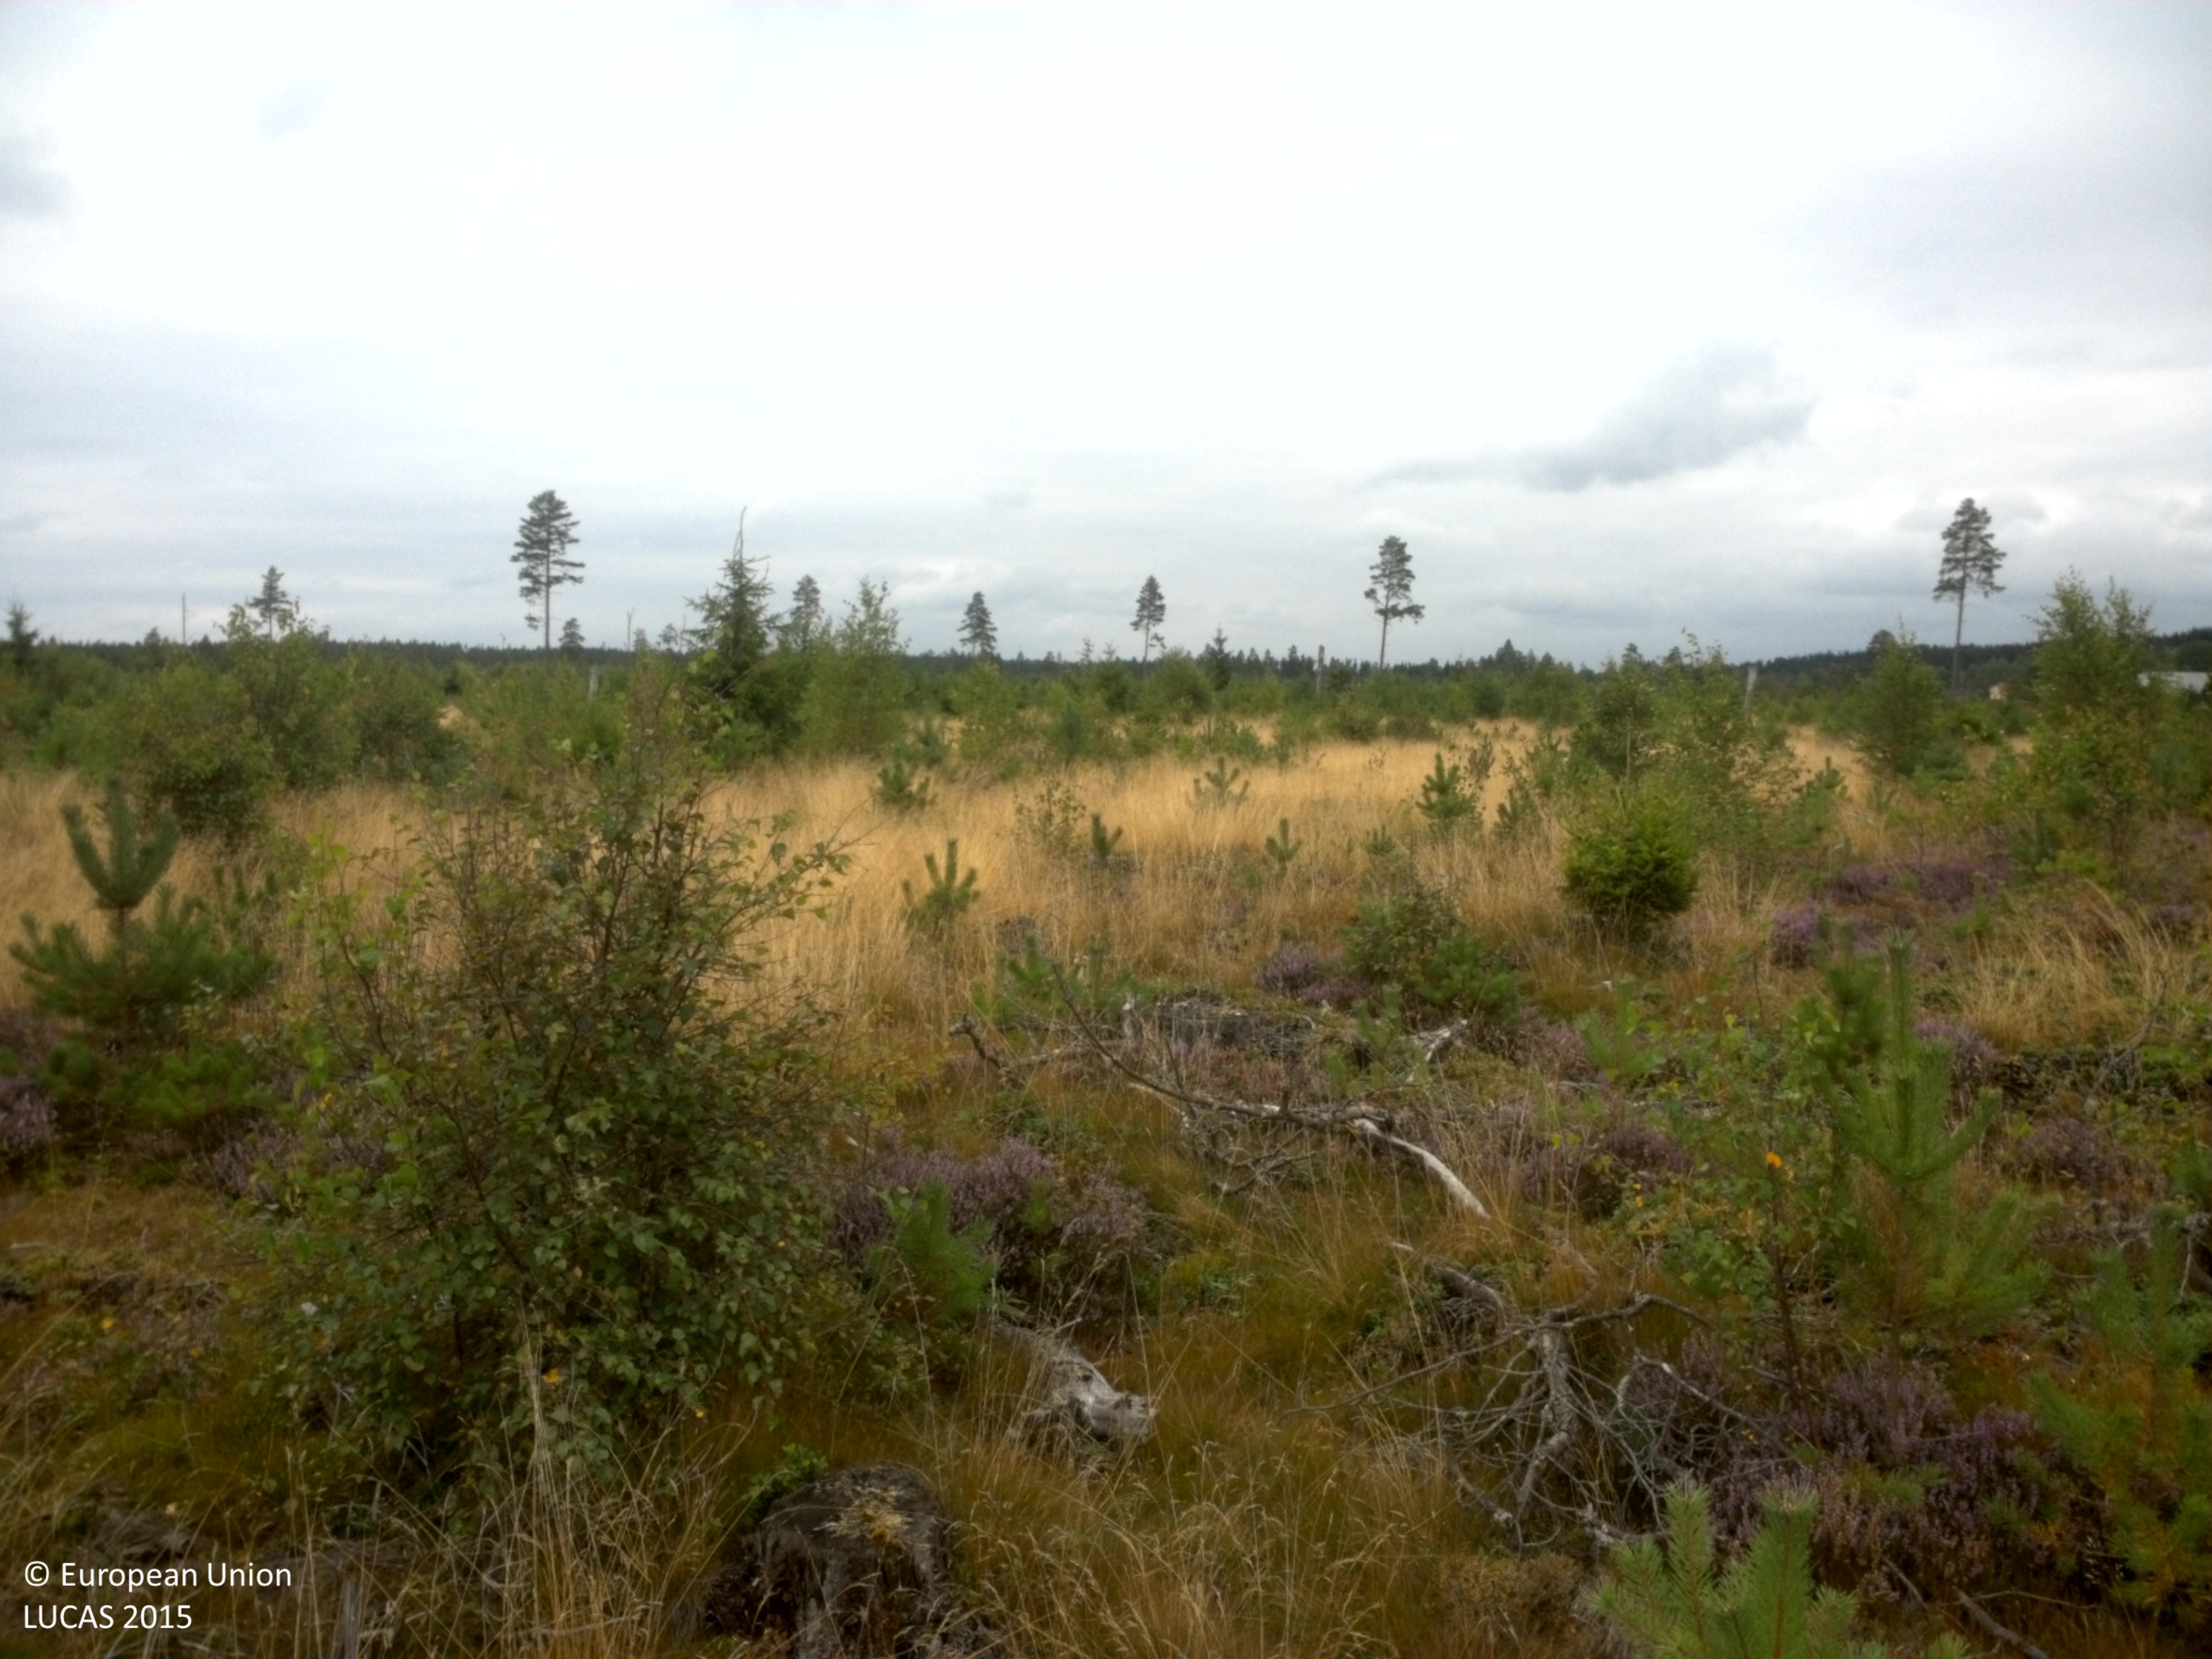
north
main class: Woodland
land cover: Pine dominated mixed woodland
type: boreal forest
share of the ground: 10 - 25 %
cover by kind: herbaceous plants 60 %, coniferous forest trees 15 %, shrubs 15 %, broadleaved forest trees 10 %
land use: Forestry
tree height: < 5 m
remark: Clear cut
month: August
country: SE
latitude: 57.8751
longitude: 13.8896
